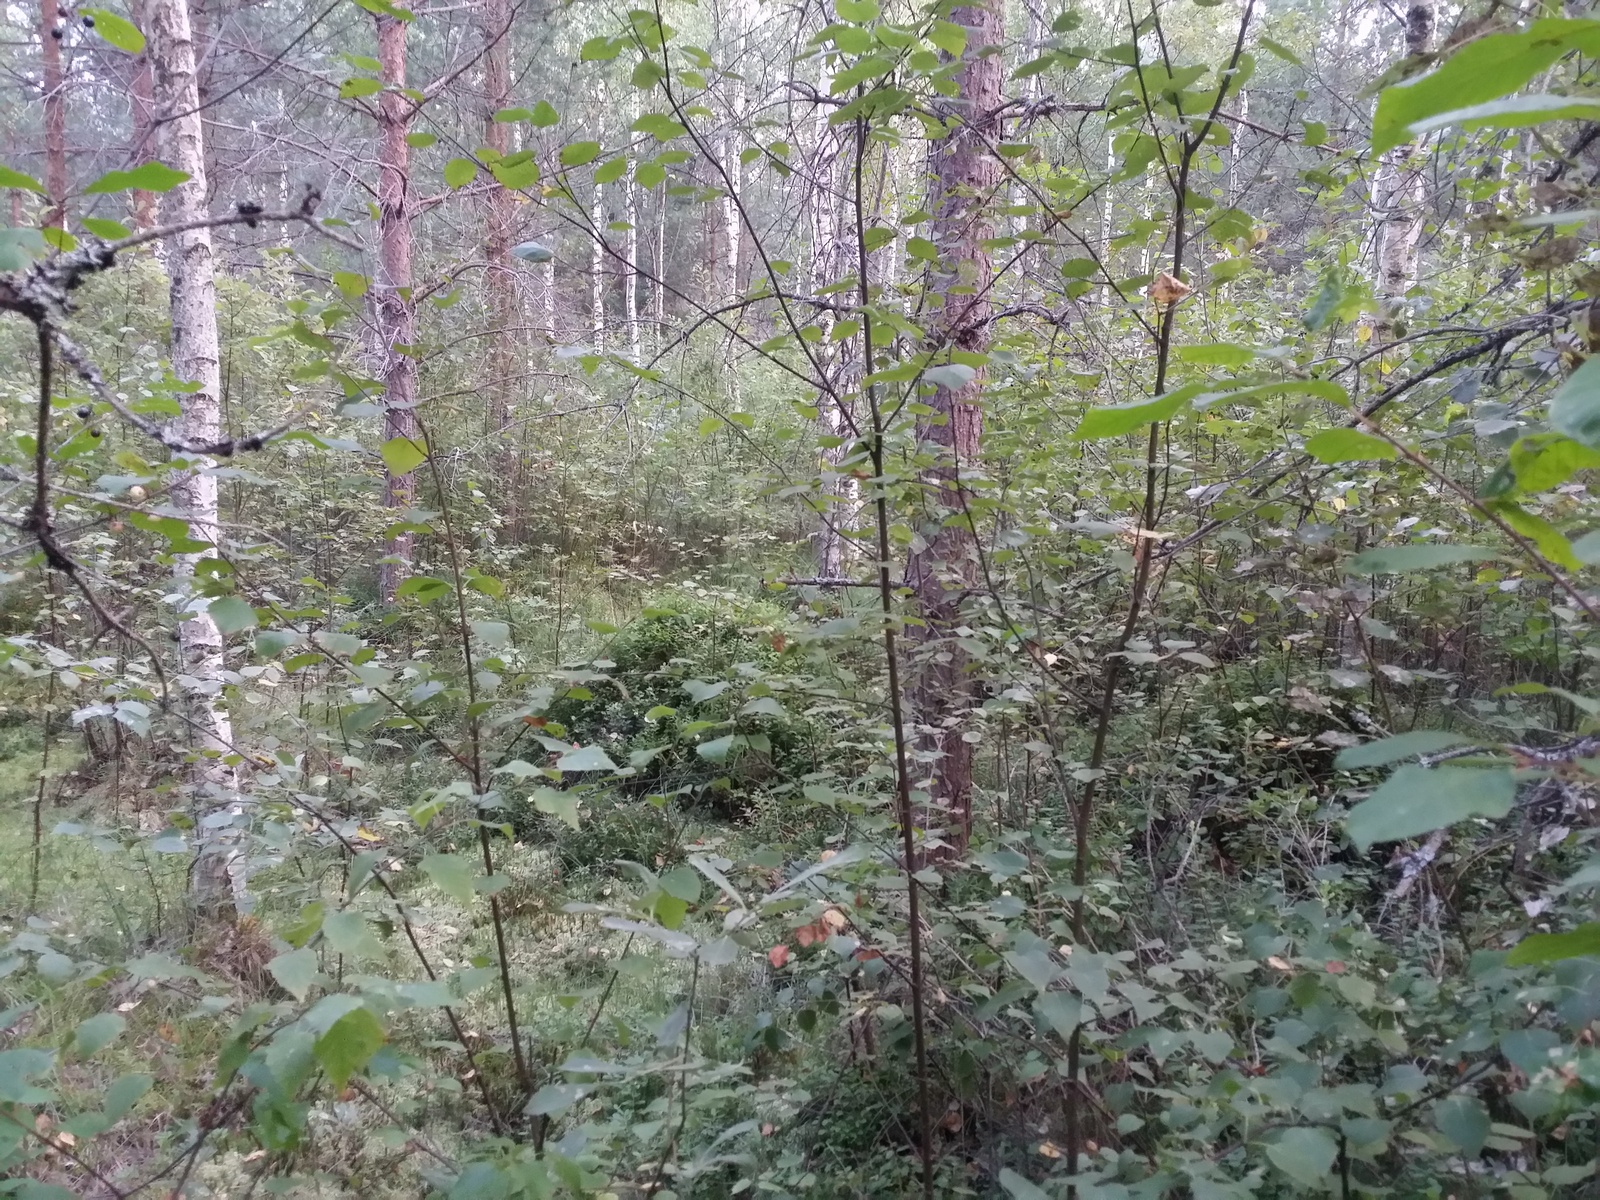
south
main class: Woodland
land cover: Pine dominated mixed woodland
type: hemiboreal forest and nemoral coniferous forest and mixed broadleaved-coniferous forest
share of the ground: > 75 %
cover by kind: coniferous forest trees 35 %, broadleaved forest trees 30 %, herbaceous plants 20 %, shrubs 10 %, lichens and mosses 5 %
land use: Forestry
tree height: > 5 m
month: August
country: LV
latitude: 56.9822
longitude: 27.2317
